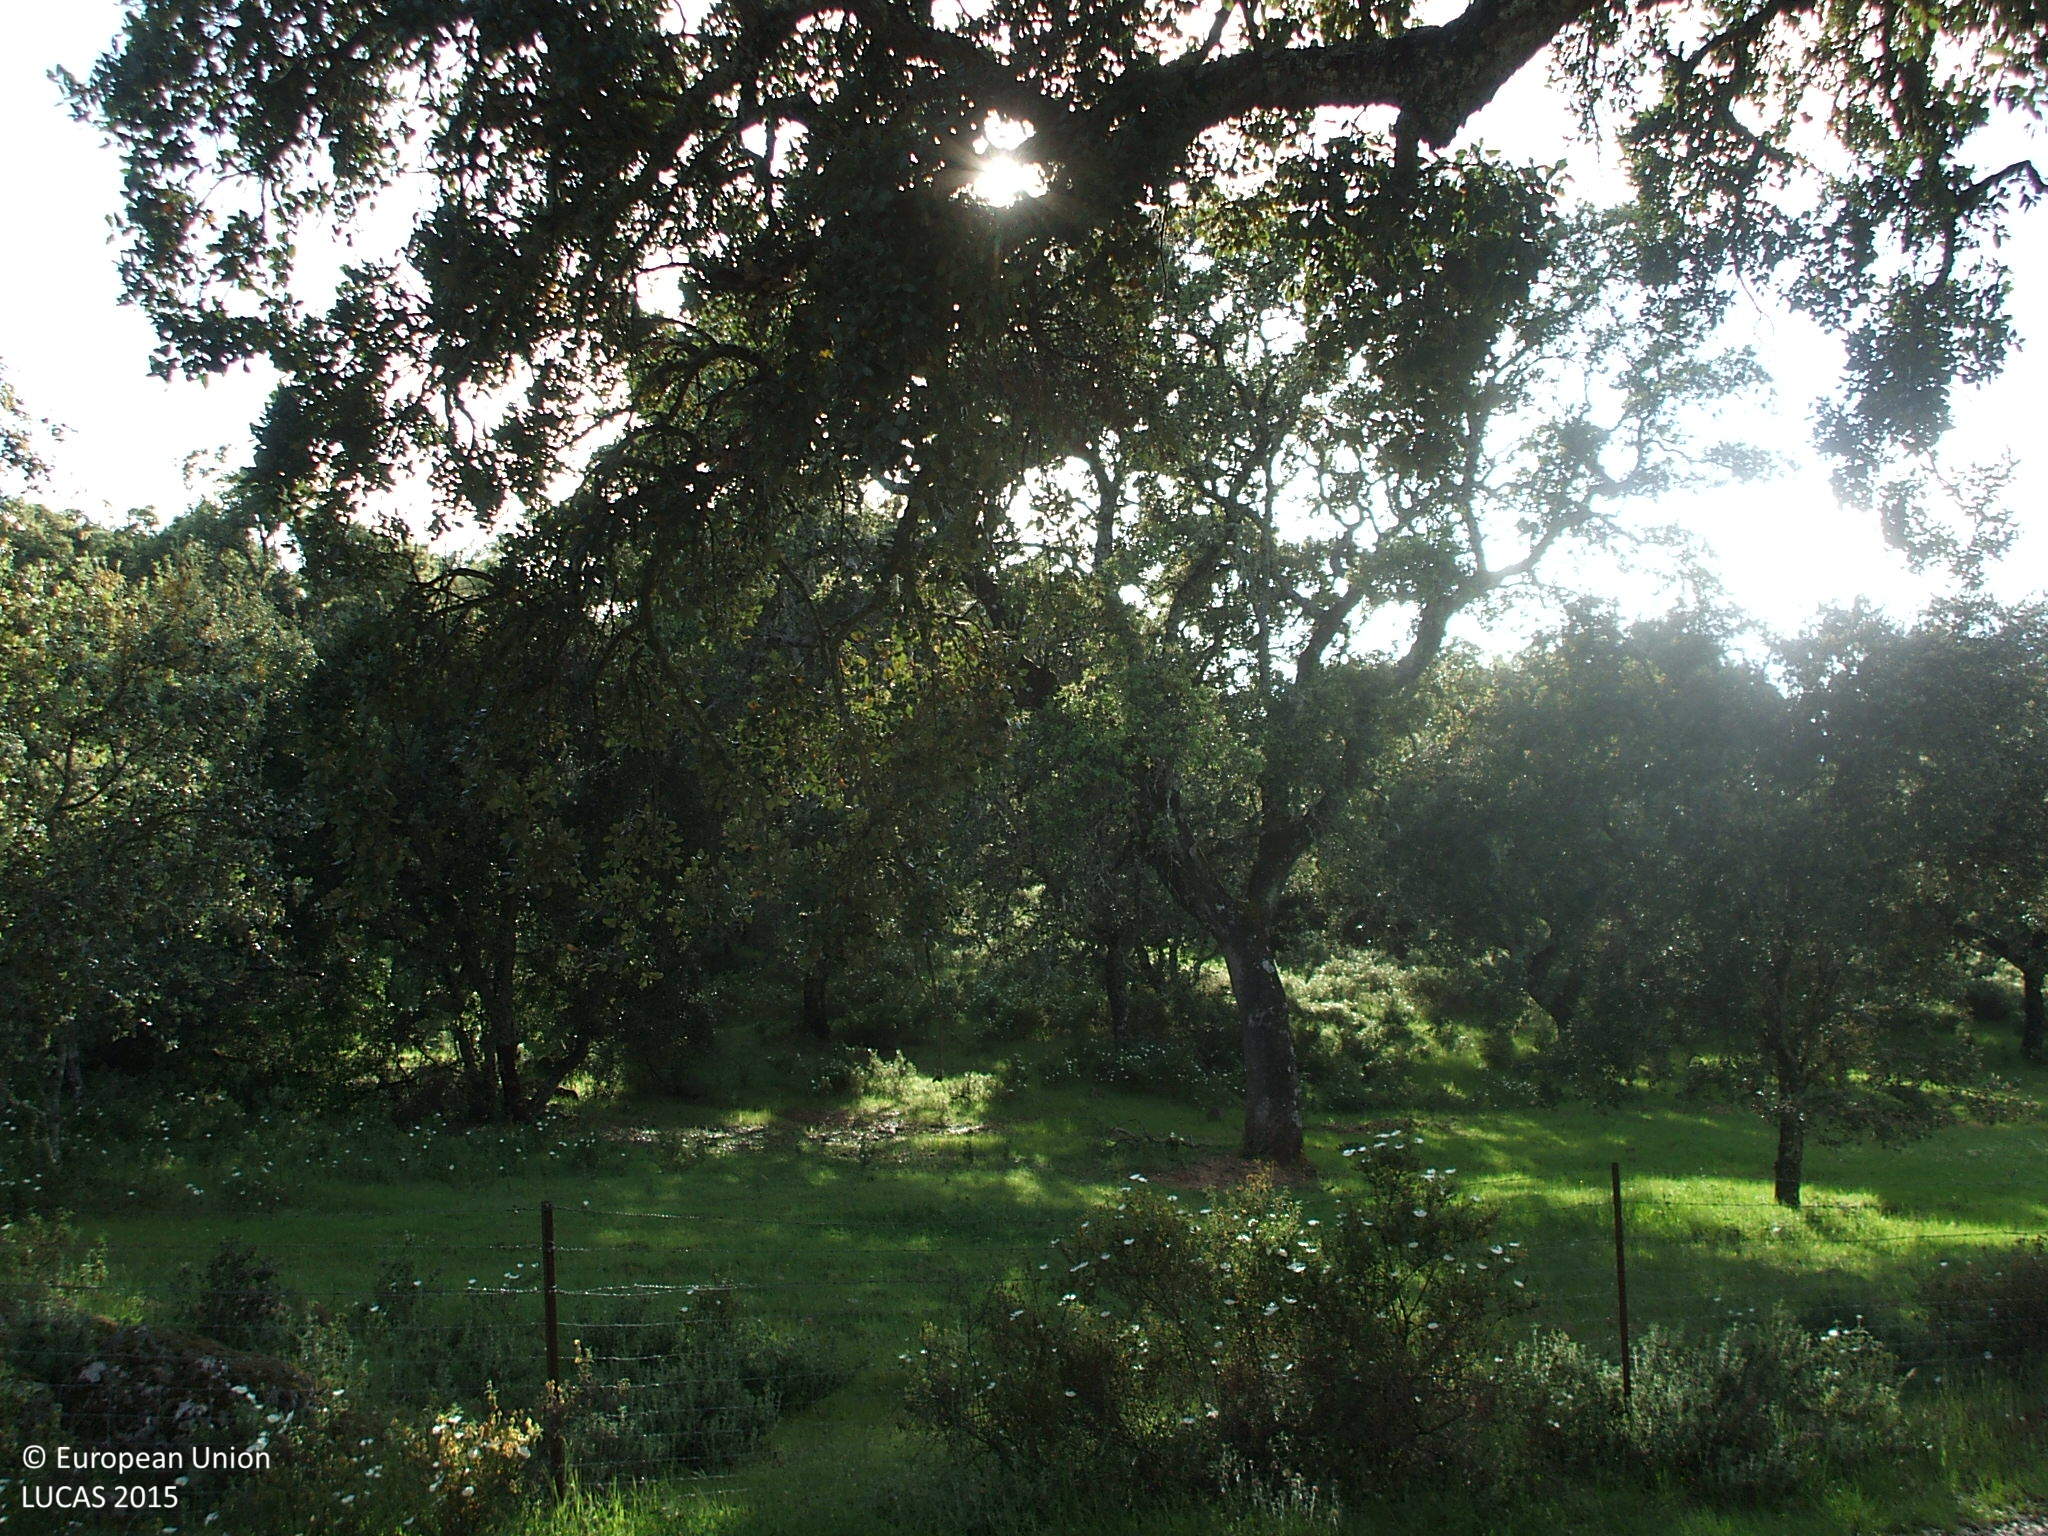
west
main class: Woodland
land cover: Broadleaved woodland
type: broadleaved evergreen forest
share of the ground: 10 - 25 %
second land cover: Grassland without tree/shrub cover
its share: > 75 %
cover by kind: herbaceous plants 80 %, broadleaved forest trees 20 %
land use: Forestry
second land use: Agriculture (excluding fallow land and kitchen gardens)
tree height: > 5 m
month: April
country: ES
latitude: 38.0202
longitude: -5.6931
